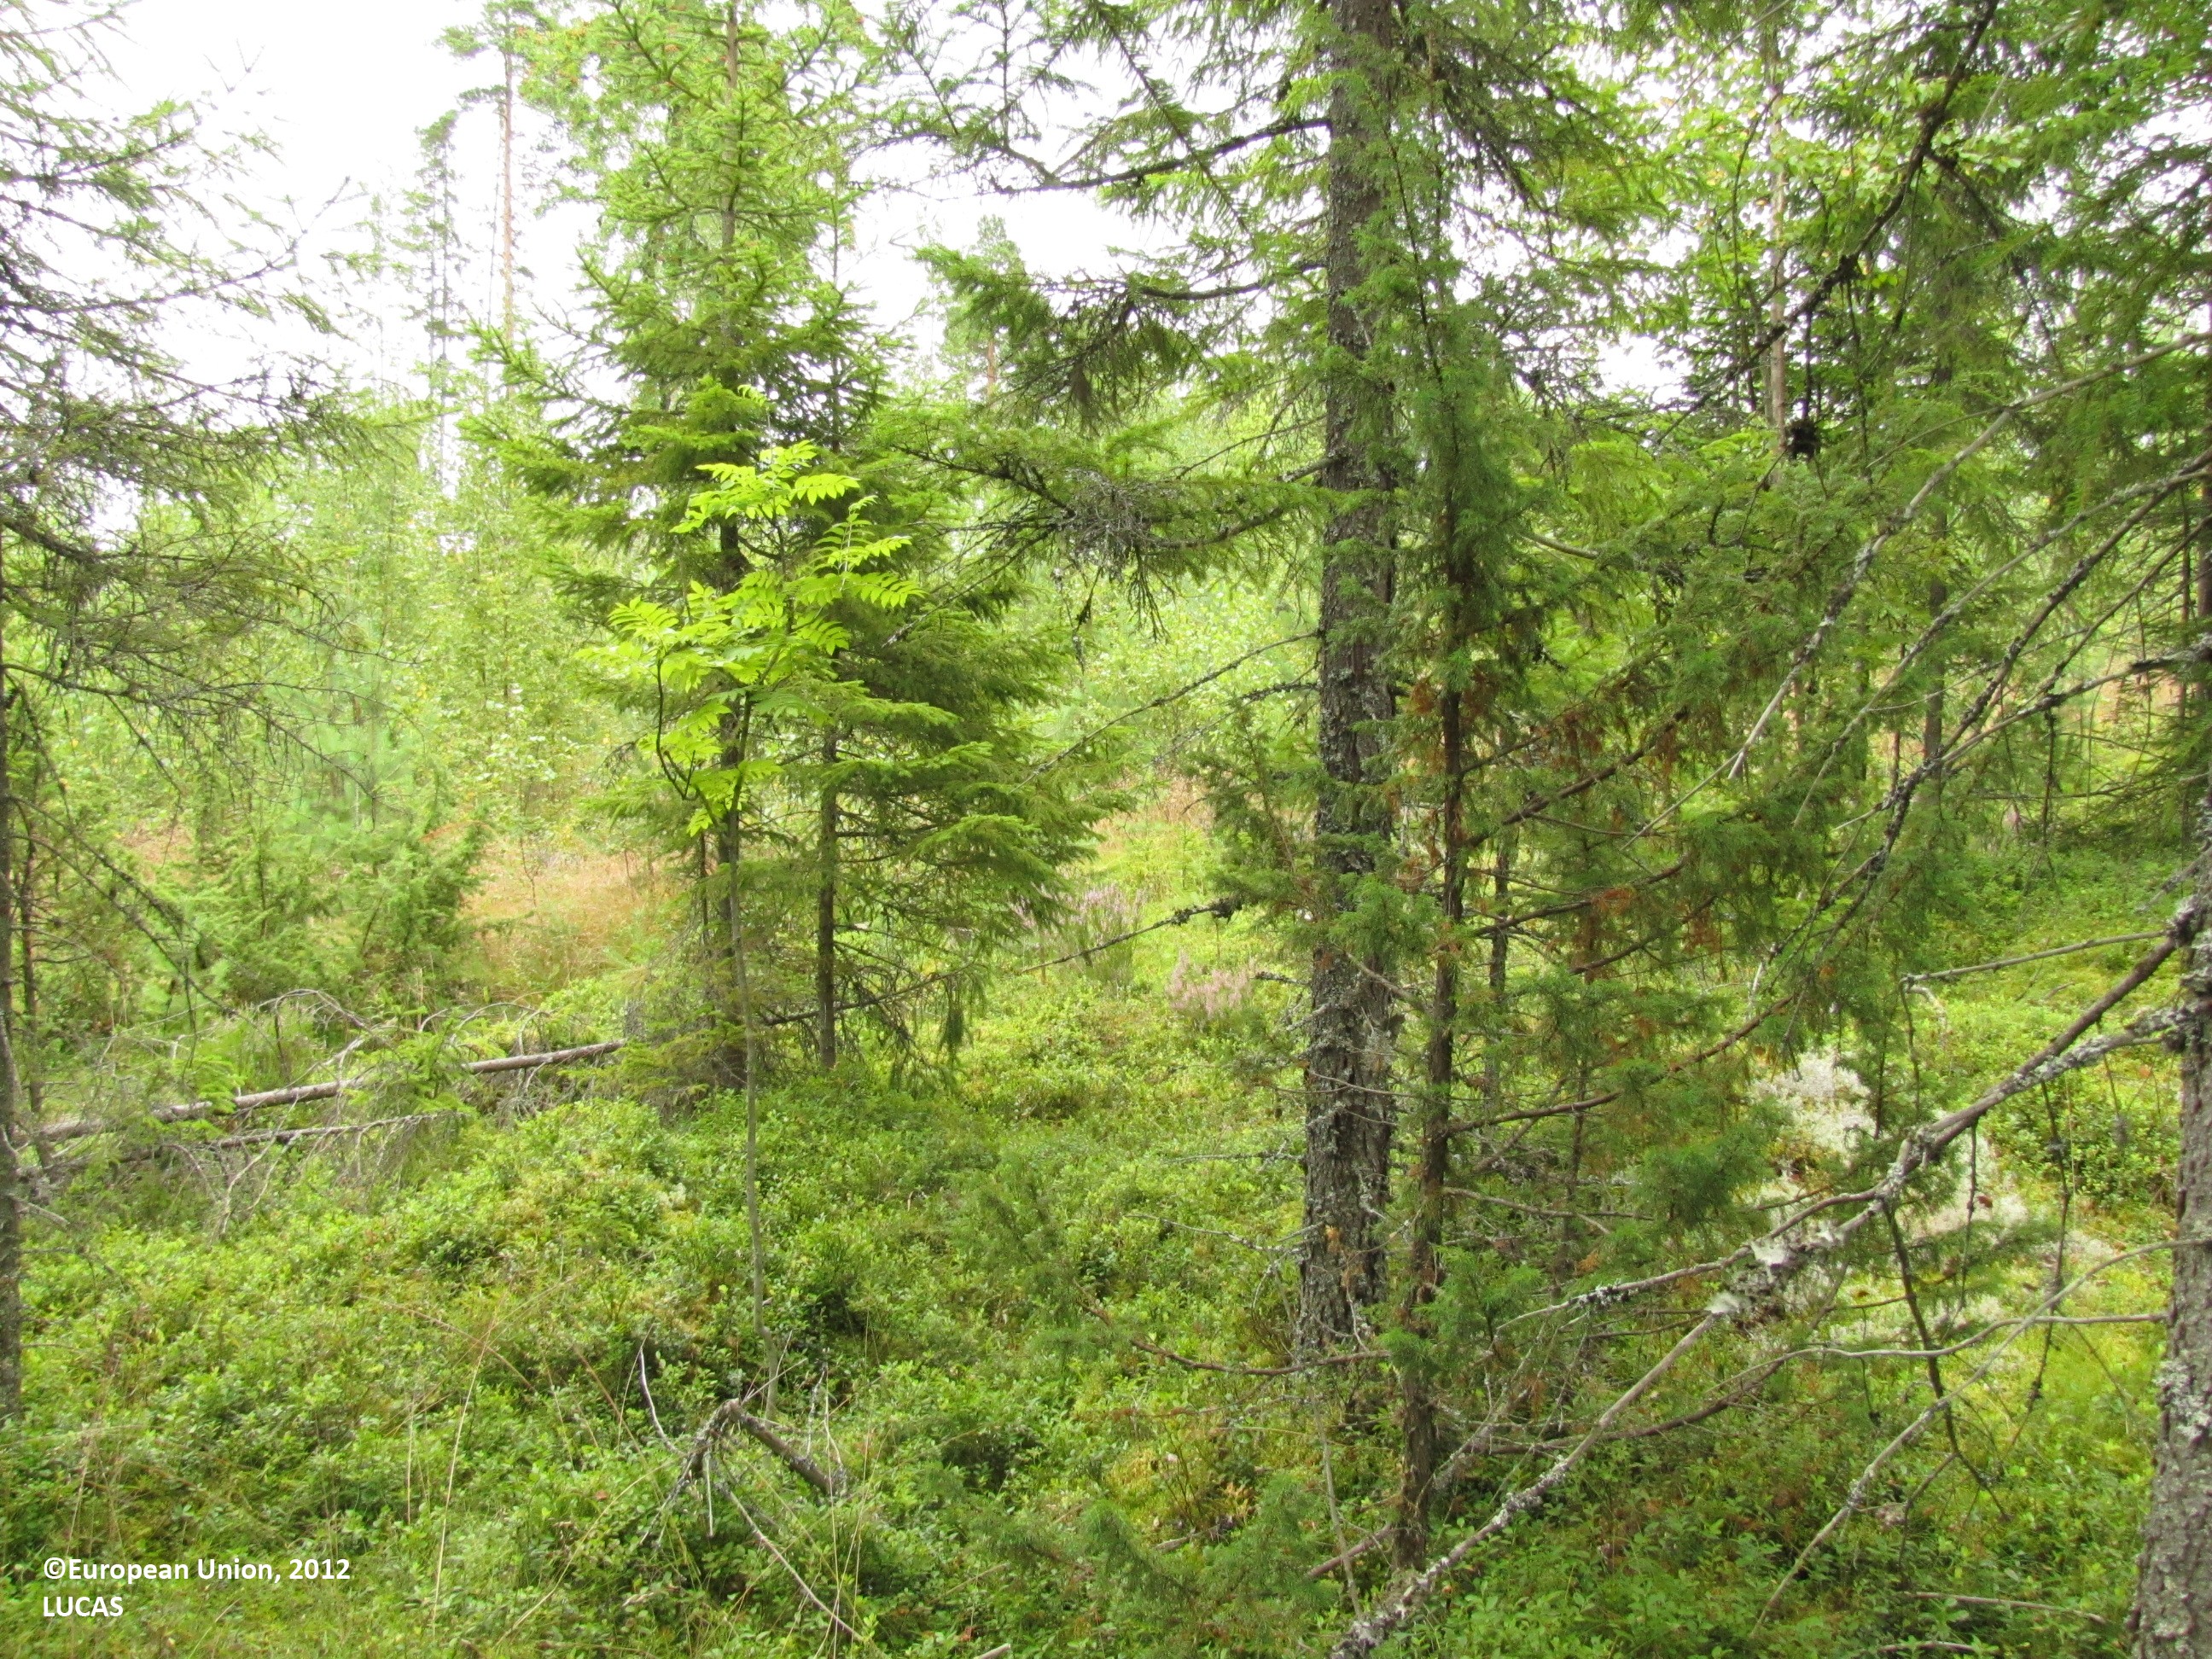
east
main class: Woodland
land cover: Spruce dominated coniferous woodland
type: boreal forest
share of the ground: 50 - 75 %
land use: Forestry
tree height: > 5 m
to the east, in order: Spruce dominated coniferous woodland; Broadleaved woodland; Pine dominated mixed woodland; Spruce dominated coniferous woodland; Broadleaved woodland
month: August
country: FI
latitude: 61.9321
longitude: 23.0424
